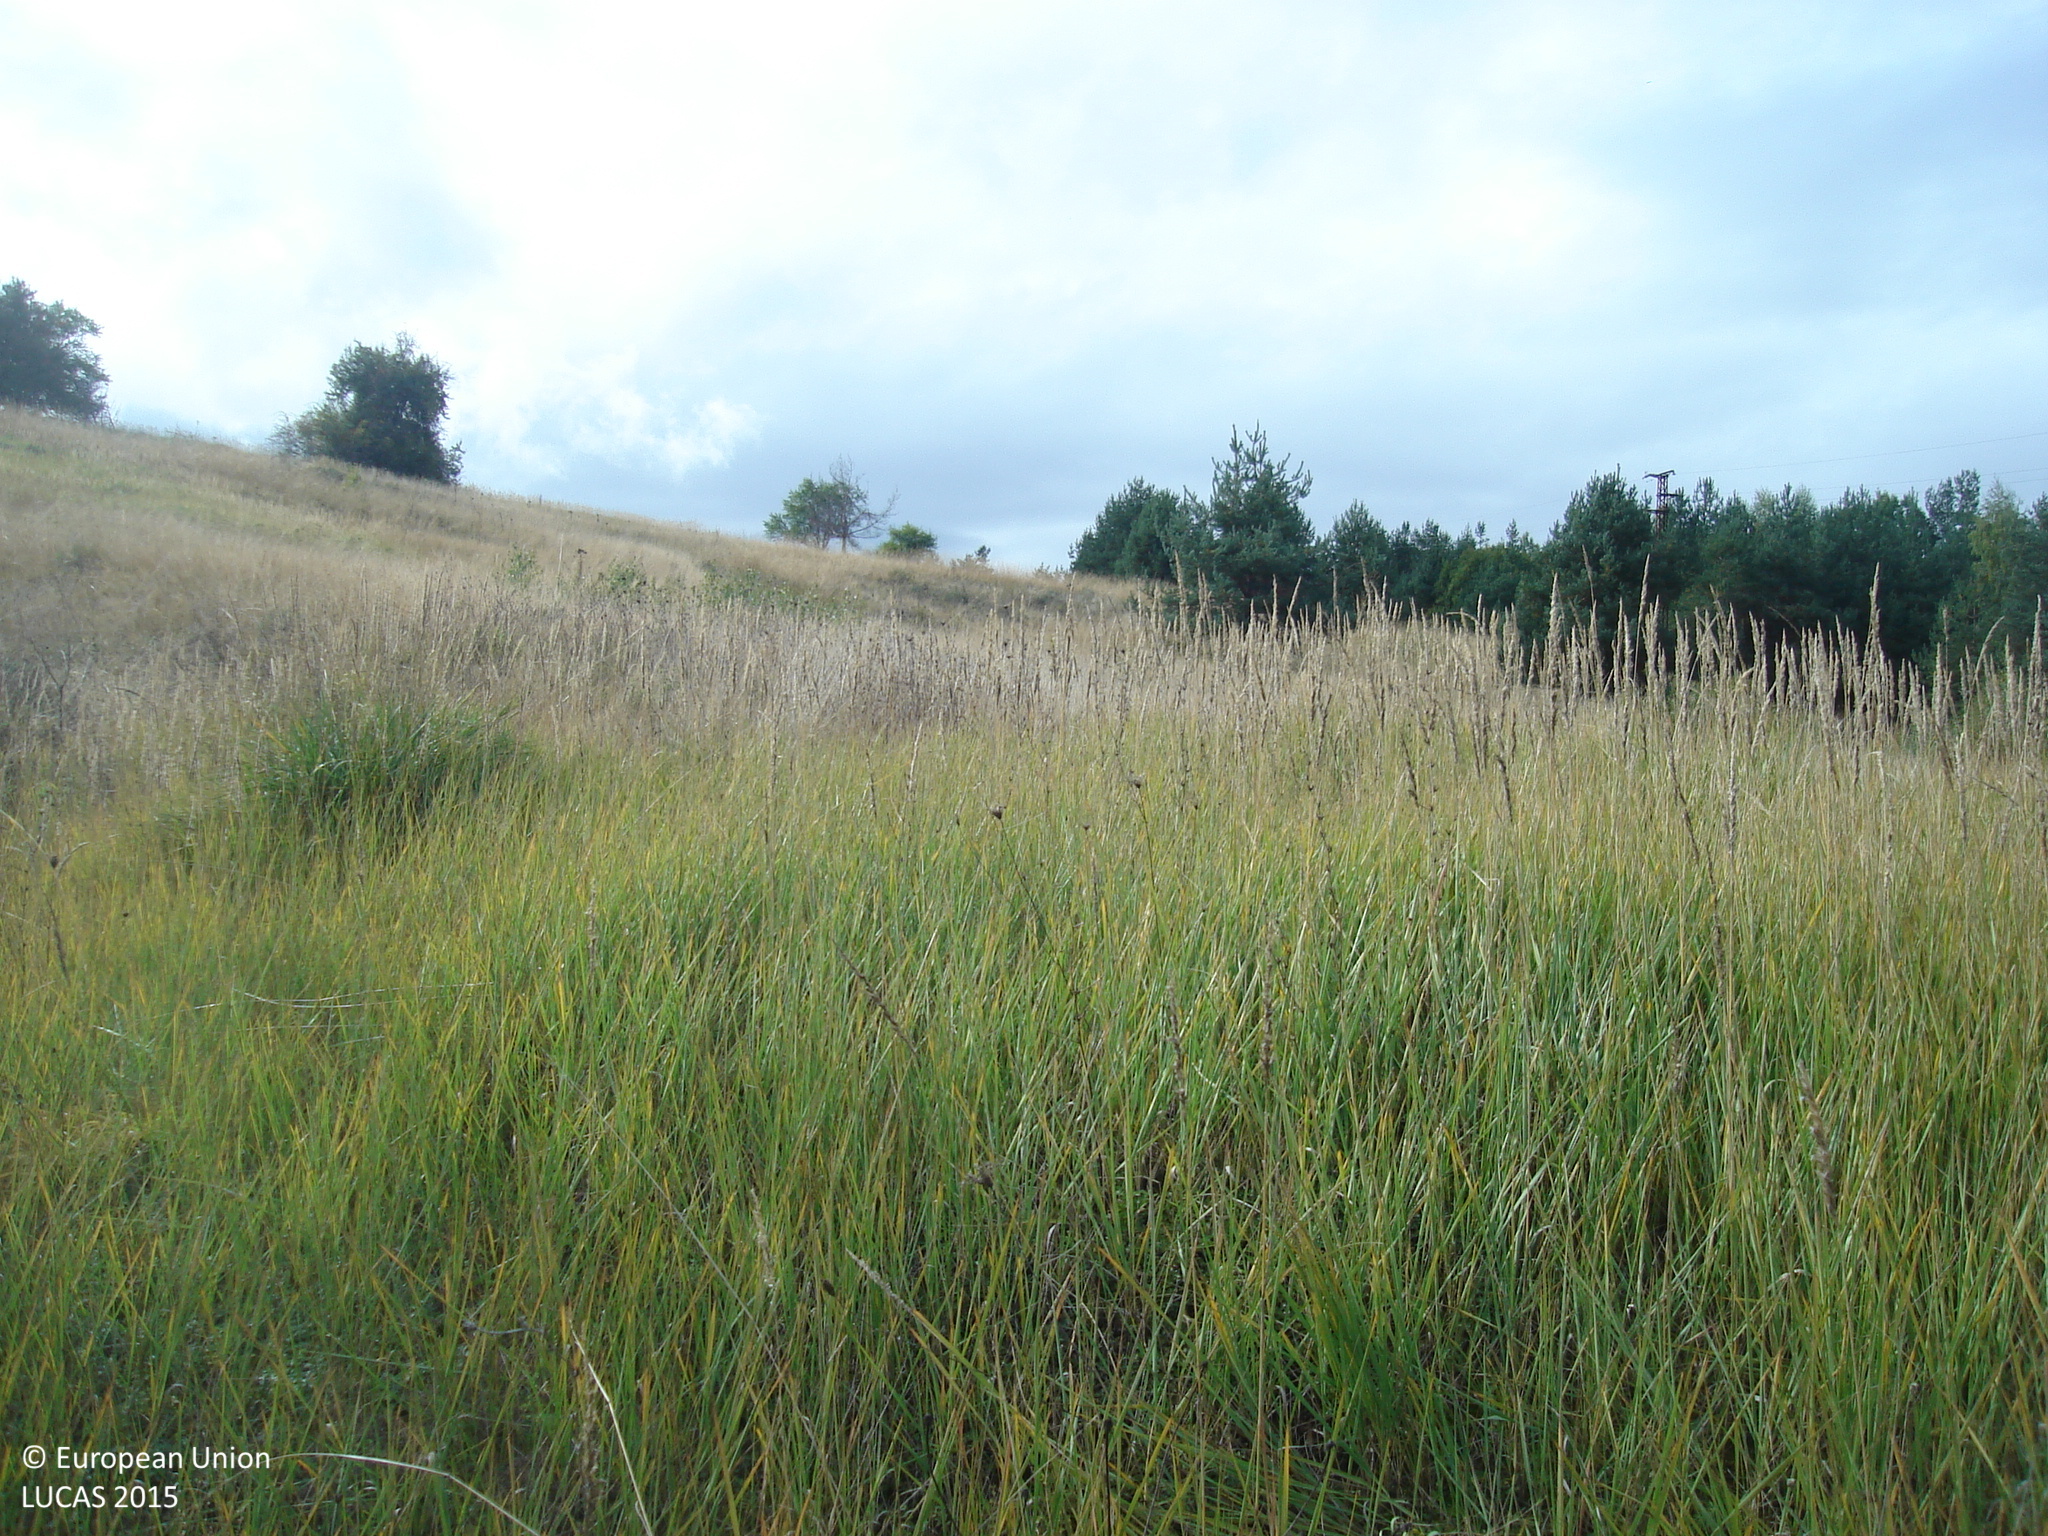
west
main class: Grassland
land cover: Grassland with sparse tree/shrub cover
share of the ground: > 75 %
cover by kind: herbaceous plants 95 %, broadleaved forest trees 5 %
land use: Agriculture (excluding fallow land and kitchen gardens)
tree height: > 5 m
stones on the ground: < 10 %
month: October
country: BG
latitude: 42.5905
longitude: 24.3932
